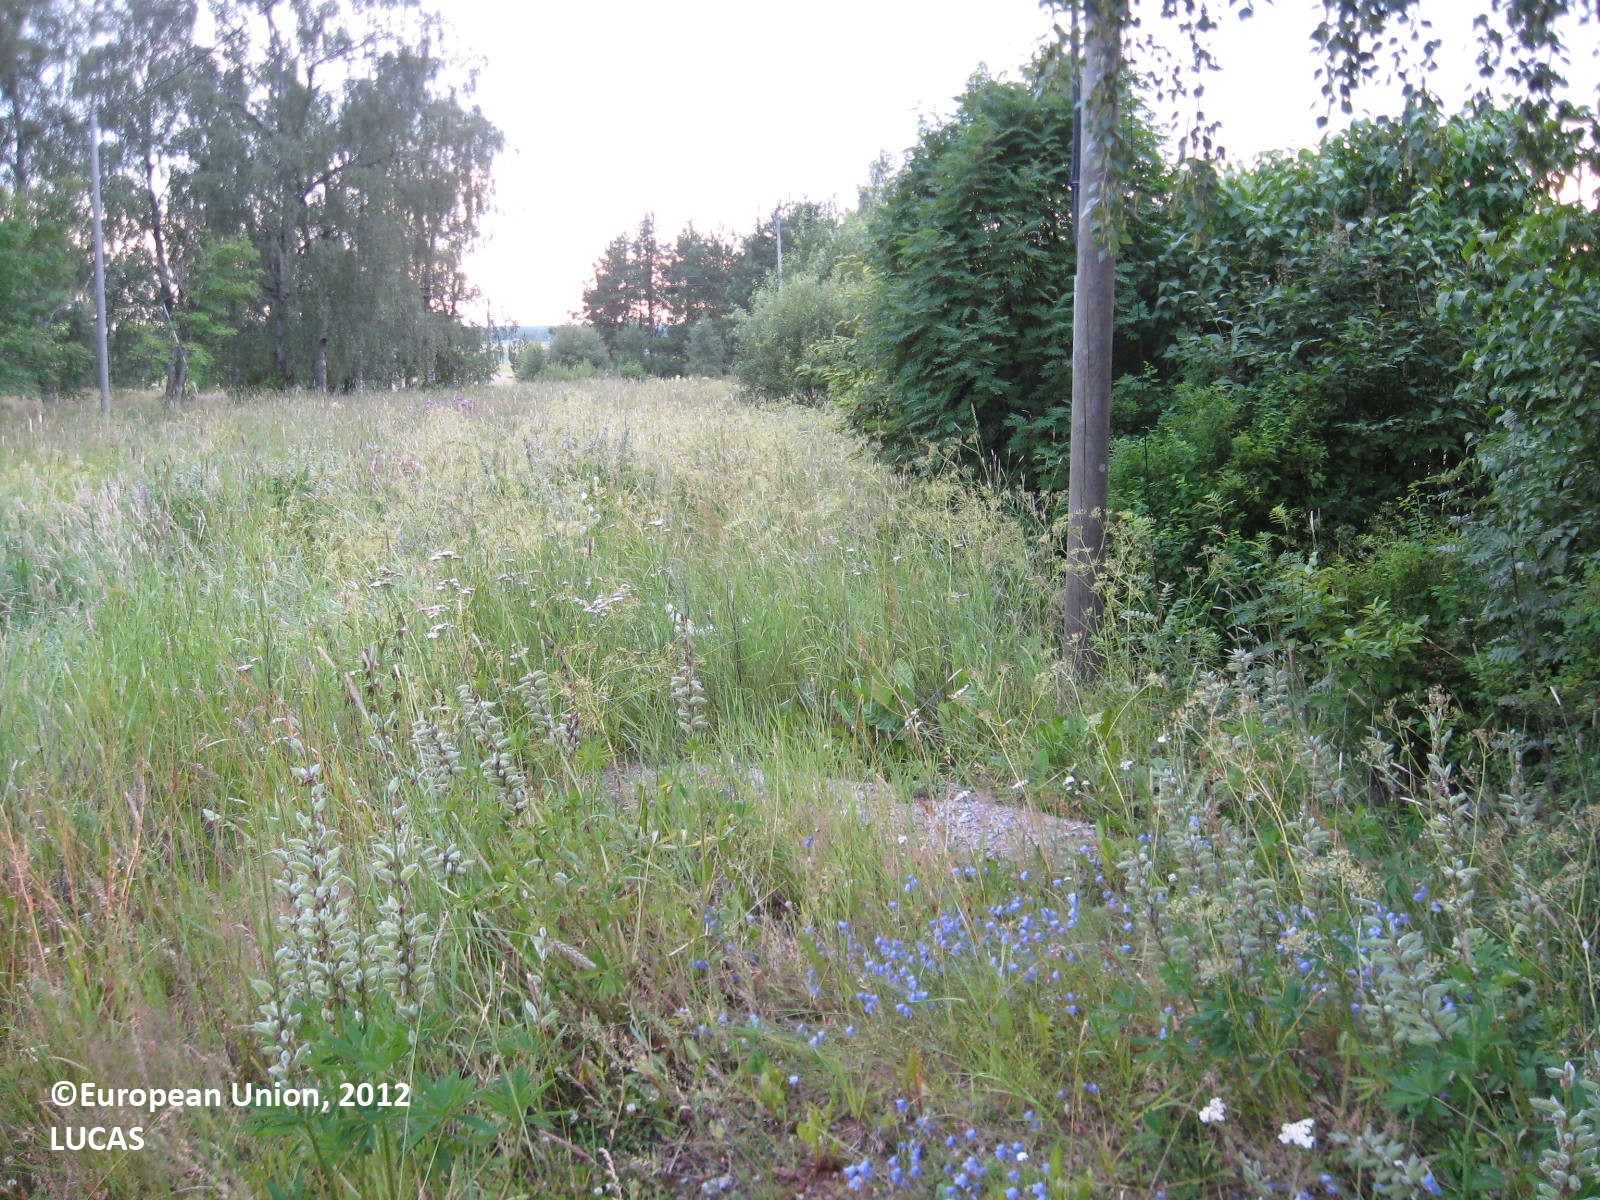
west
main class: Grassland
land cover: Grassland without tree/shrub cover
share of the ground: > 75 %
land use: Residential
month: July
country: FI
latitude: 62.5391
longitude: 21.4526
